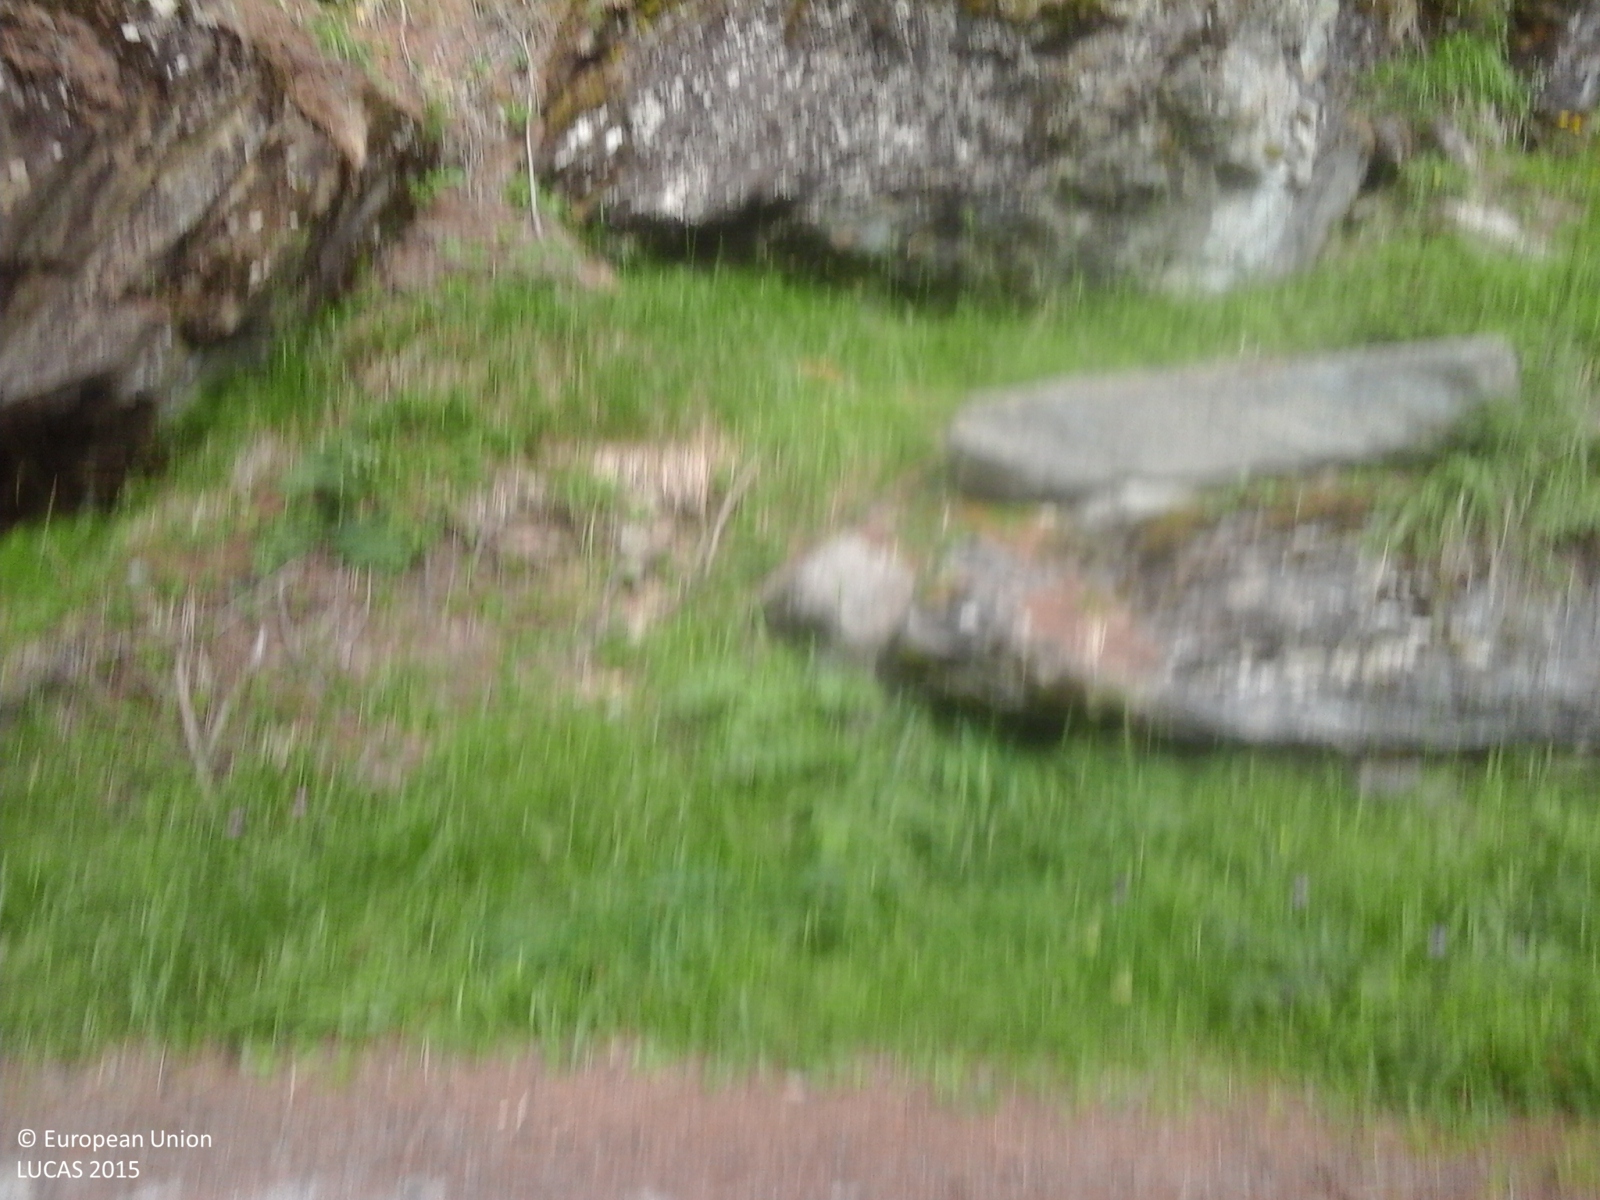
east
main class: Woodland
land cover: Spruce dominated coniferous woodland
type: alpine coniferous forest
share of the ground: > 75 %
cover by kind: coniferous forest trees 100 %
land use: Semi-natural and natural areas not in use
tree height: > 5 m
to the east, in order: Spruce dominated coniferous woodland
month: July
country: IT
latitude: 46.2791
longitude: 9.9093
